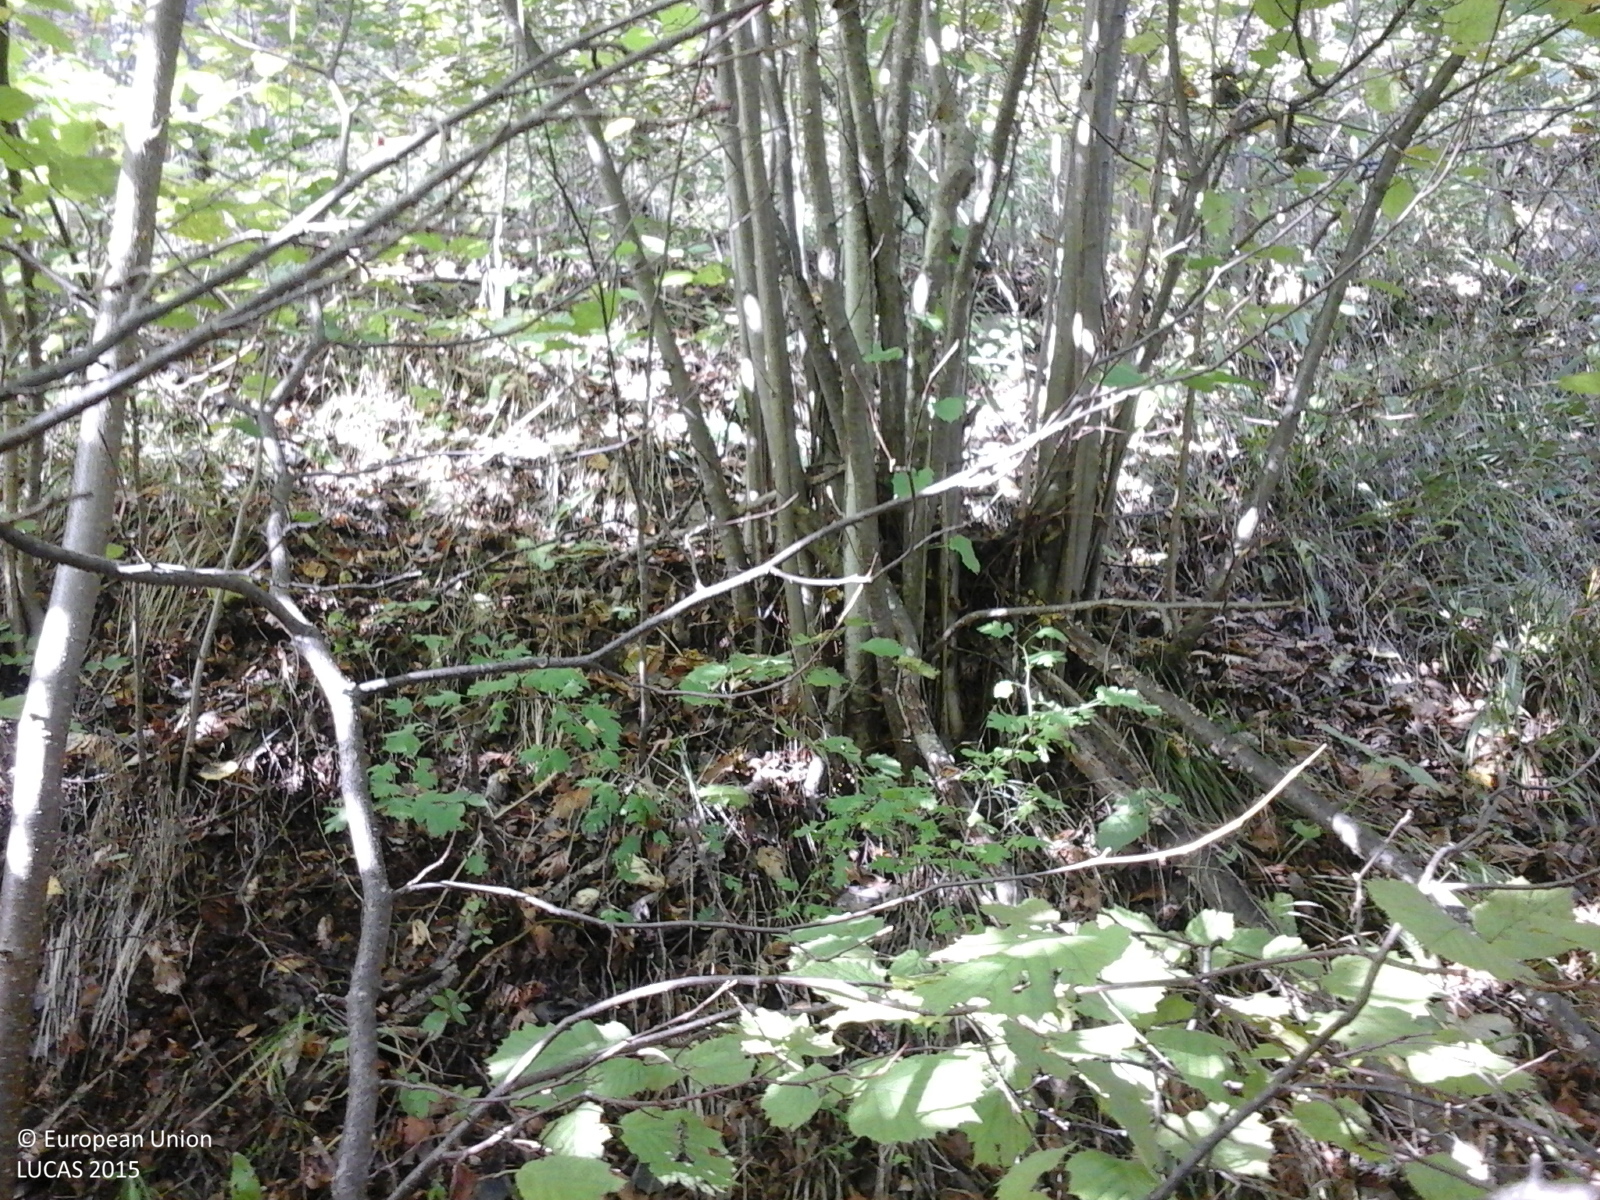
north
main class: Woodland
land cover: Broadleaved woodland
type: mesophytic deciduous forest
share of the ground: > 75 %
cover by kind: broadleaved forest trees 100 %
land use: Forestry
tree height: < 5 m
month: October
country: RO
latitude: 46.5524
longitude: 23.3296
